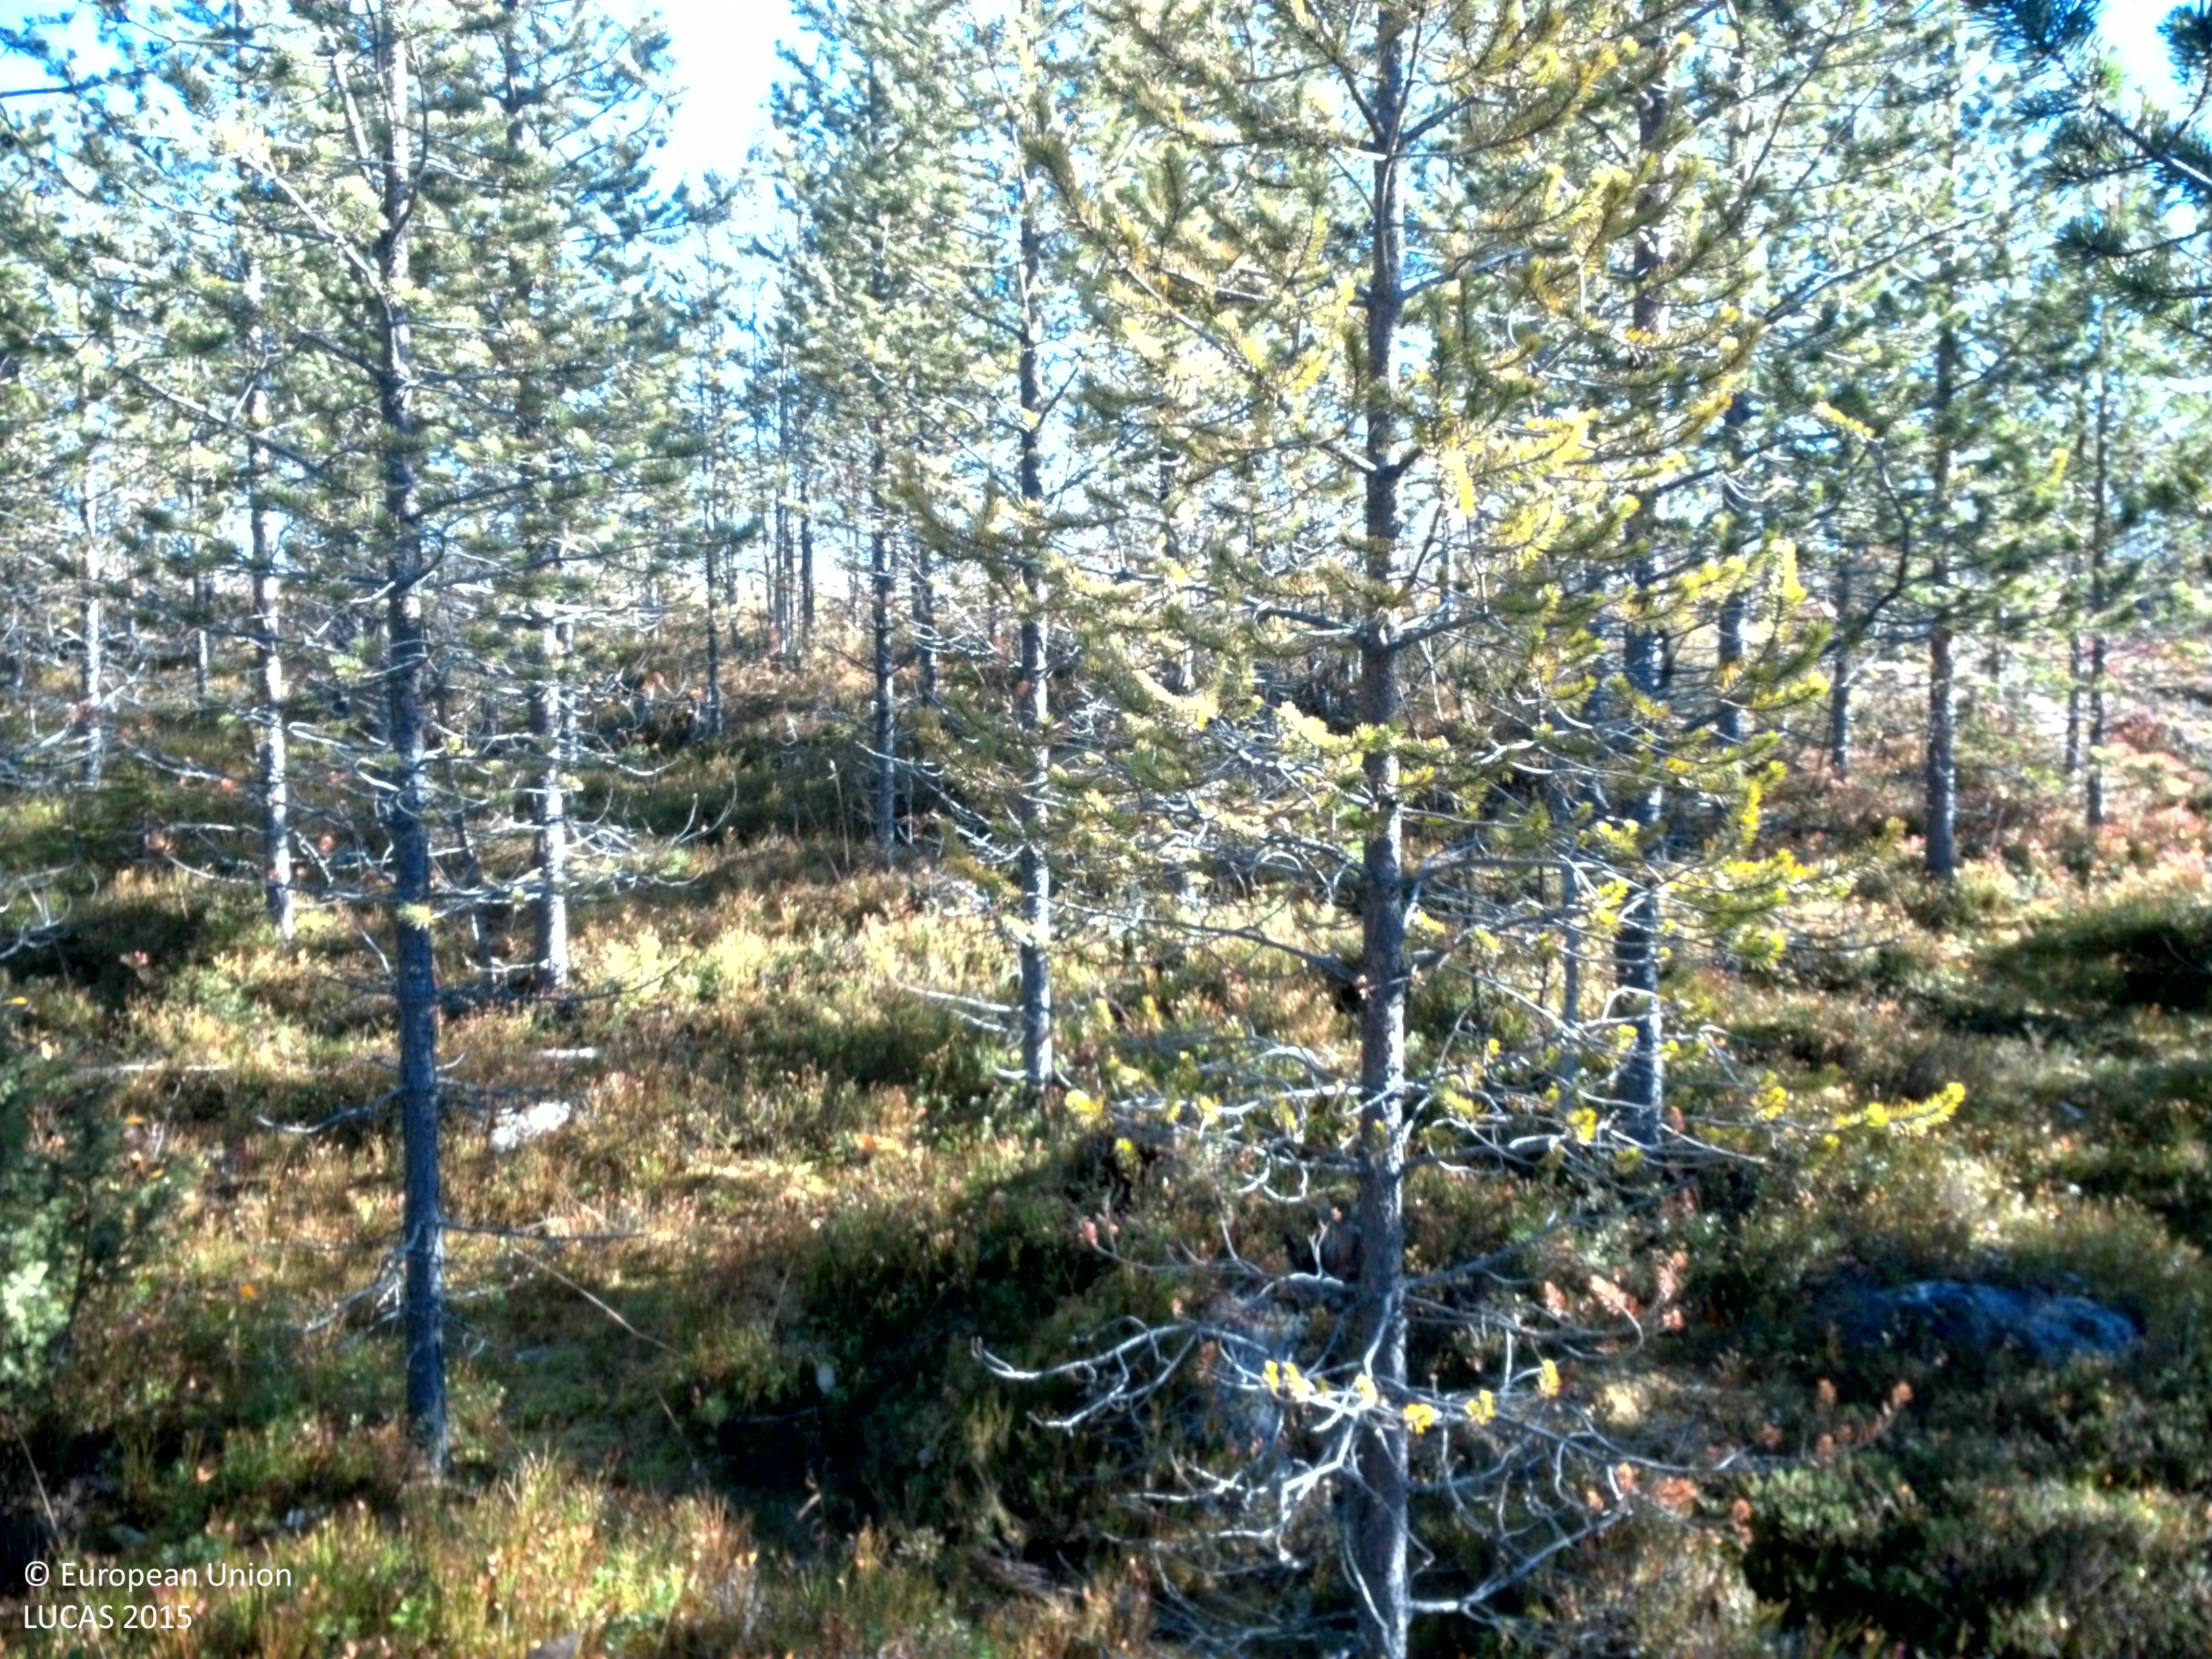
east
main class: Woodland
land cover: Pine dominated coniferous woodland
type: boreal forest
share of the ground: 50 - 75 %
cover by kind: coniferous forest trees 45 %, shrubs 30 %, lichens and mosses 15 %, broadleaved forest trees 5 %, herbaceous plants 5 %
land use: Forestry
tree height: > 5 m
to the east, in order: Pine dominated coniferous woodland; Shrubland with sparse tree cover; Spruce dominated mixed woodland; Shrubland with sparse tree cover
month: October
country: SE
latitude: 64.8244
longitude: 17.4020
